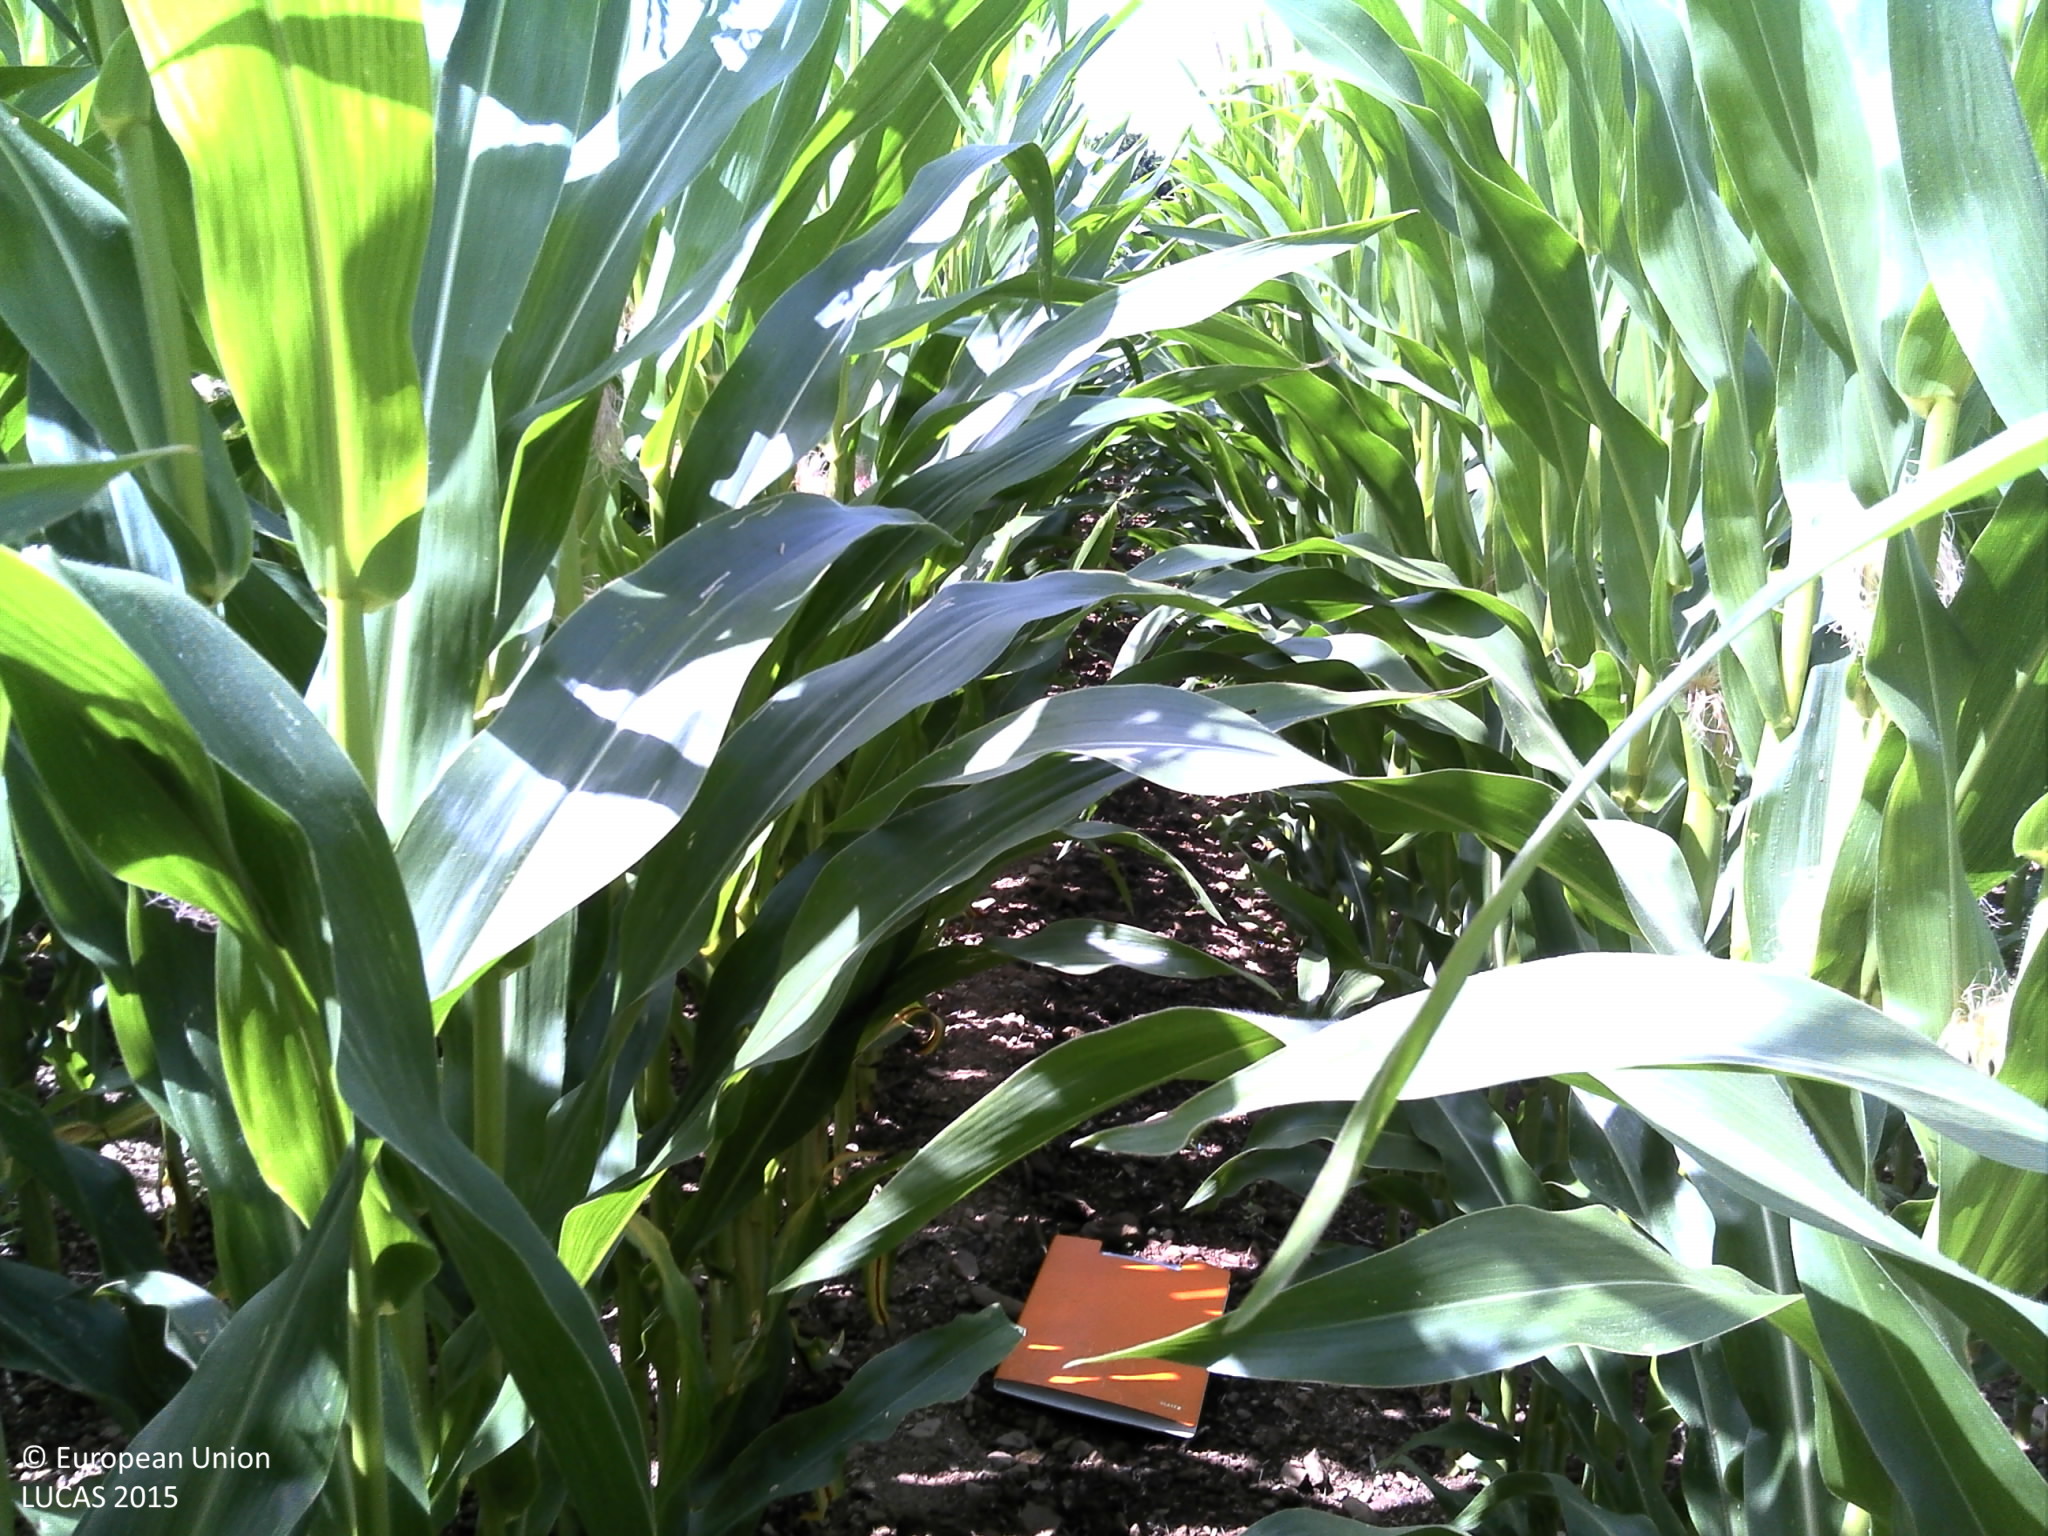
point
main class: Cropland
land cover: Maize
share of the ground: > 75 %
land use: Agriculture (excluding fallow land and kitchen gardens)
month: July
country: FR
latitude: 48.2927
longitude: -3.7092
